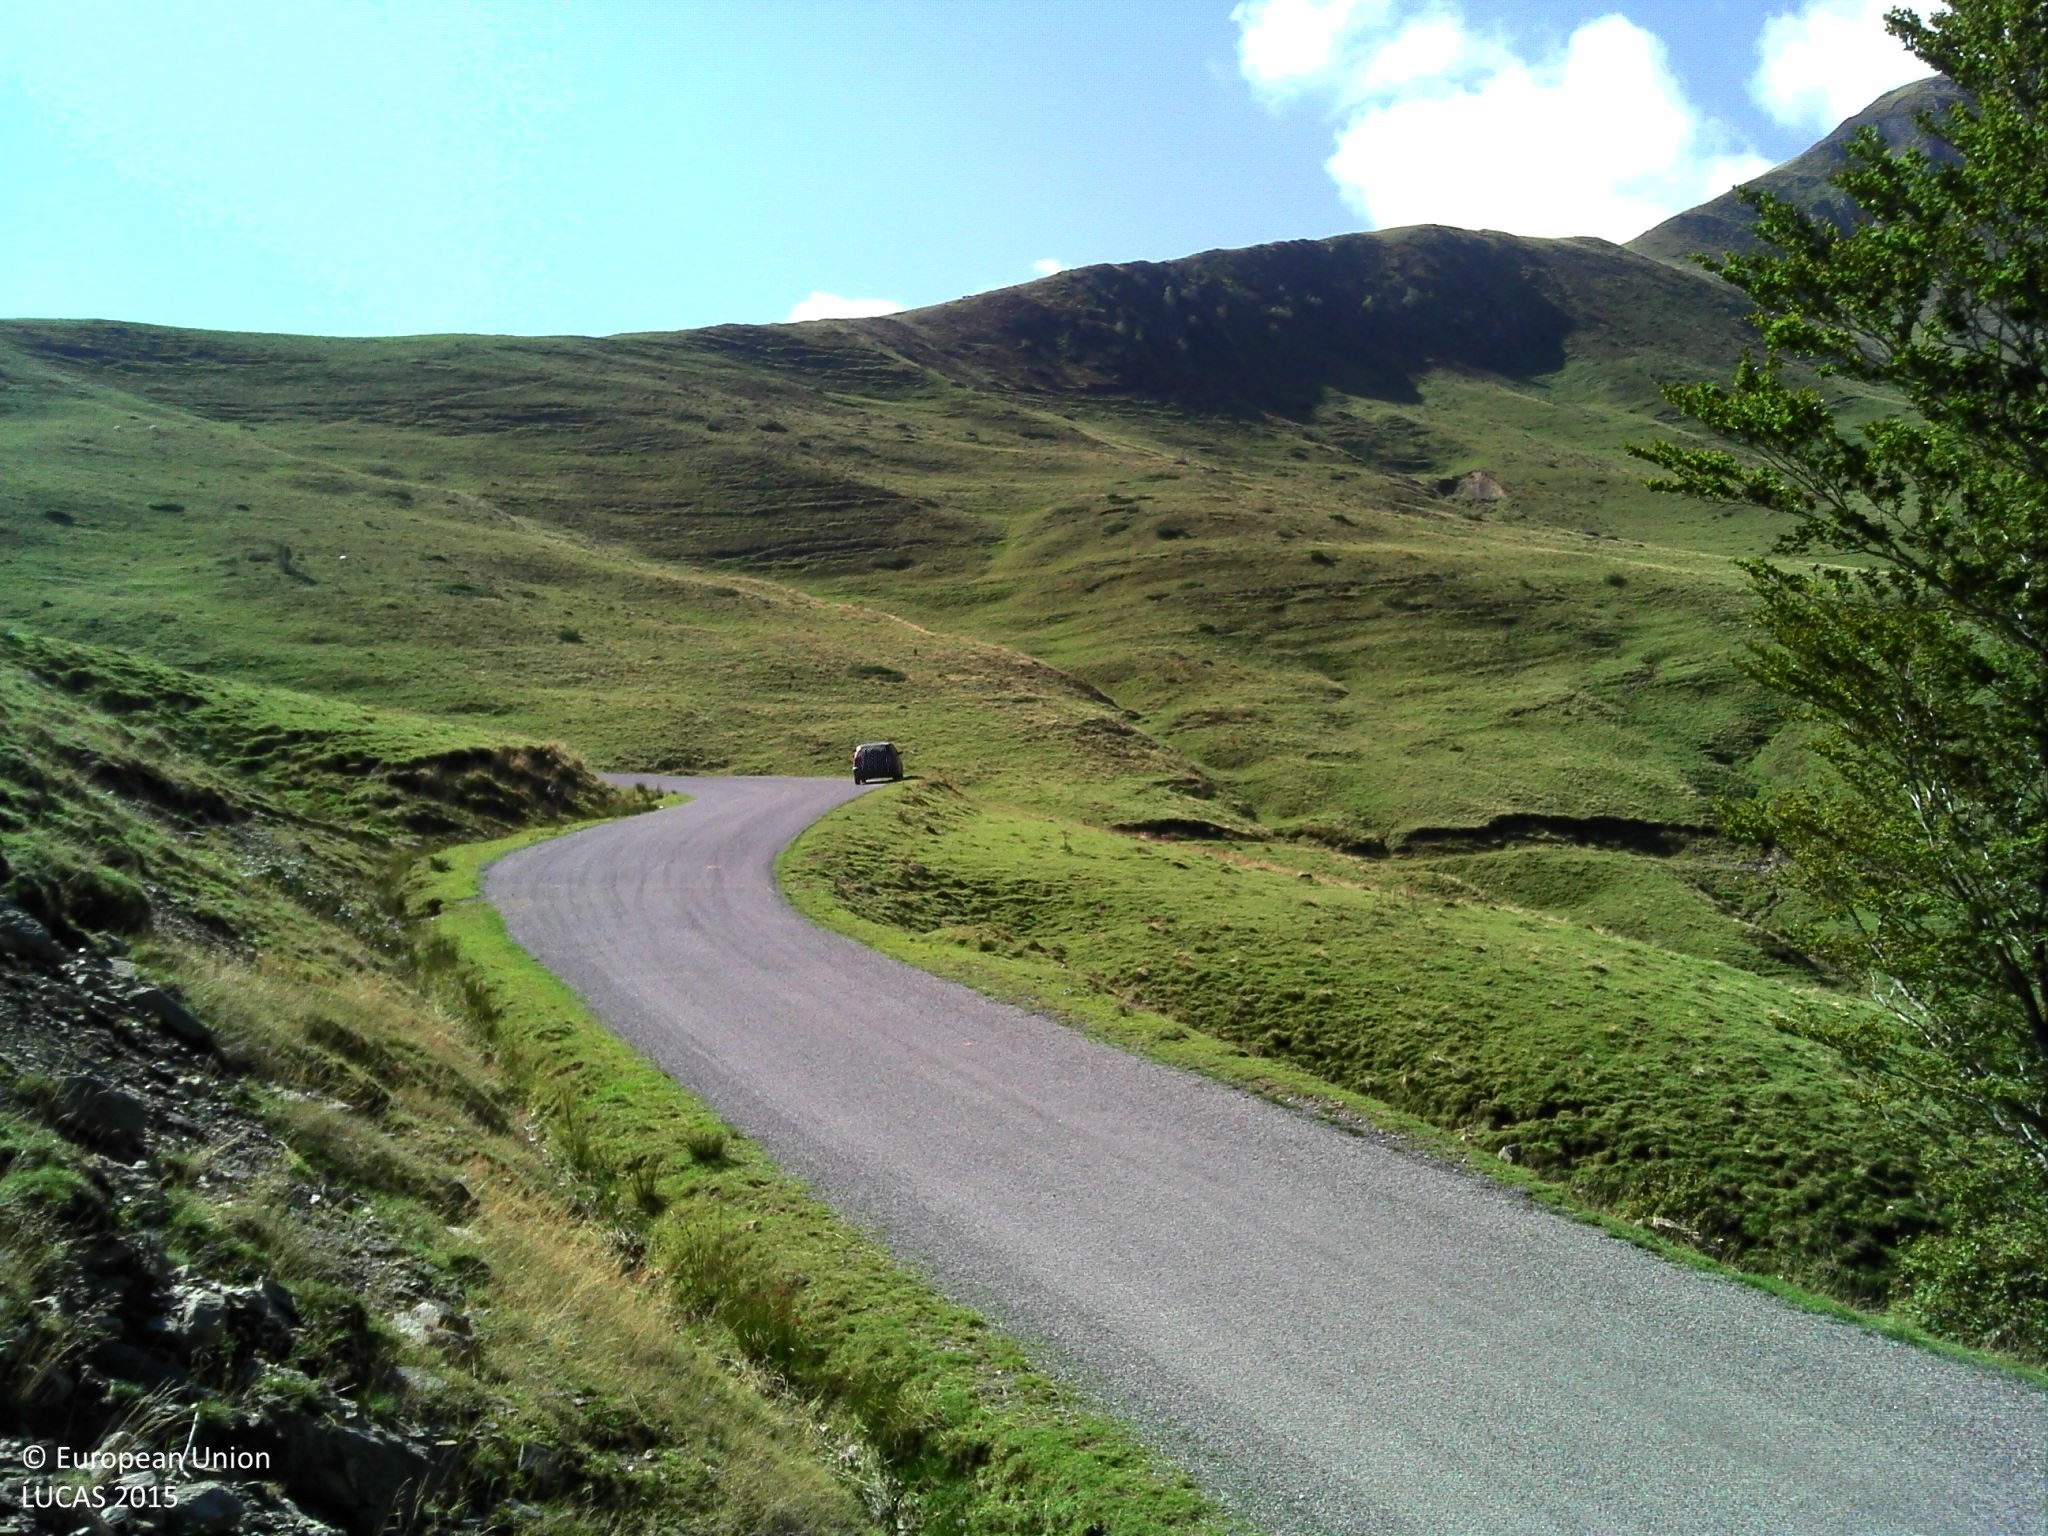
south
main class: Grassland
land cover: Spontaneously vegetated surfaces
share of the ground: 50 - 75 %
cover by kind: herbaceous plants 55 %, unconsolidated bare surface 30 %, consolidated bare surface 10 %, shrubs 5 %
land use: Agriculture (excluding fallow land and kitchen gardens)
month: September
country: FR
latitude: 43.0010
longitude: -0.9887
